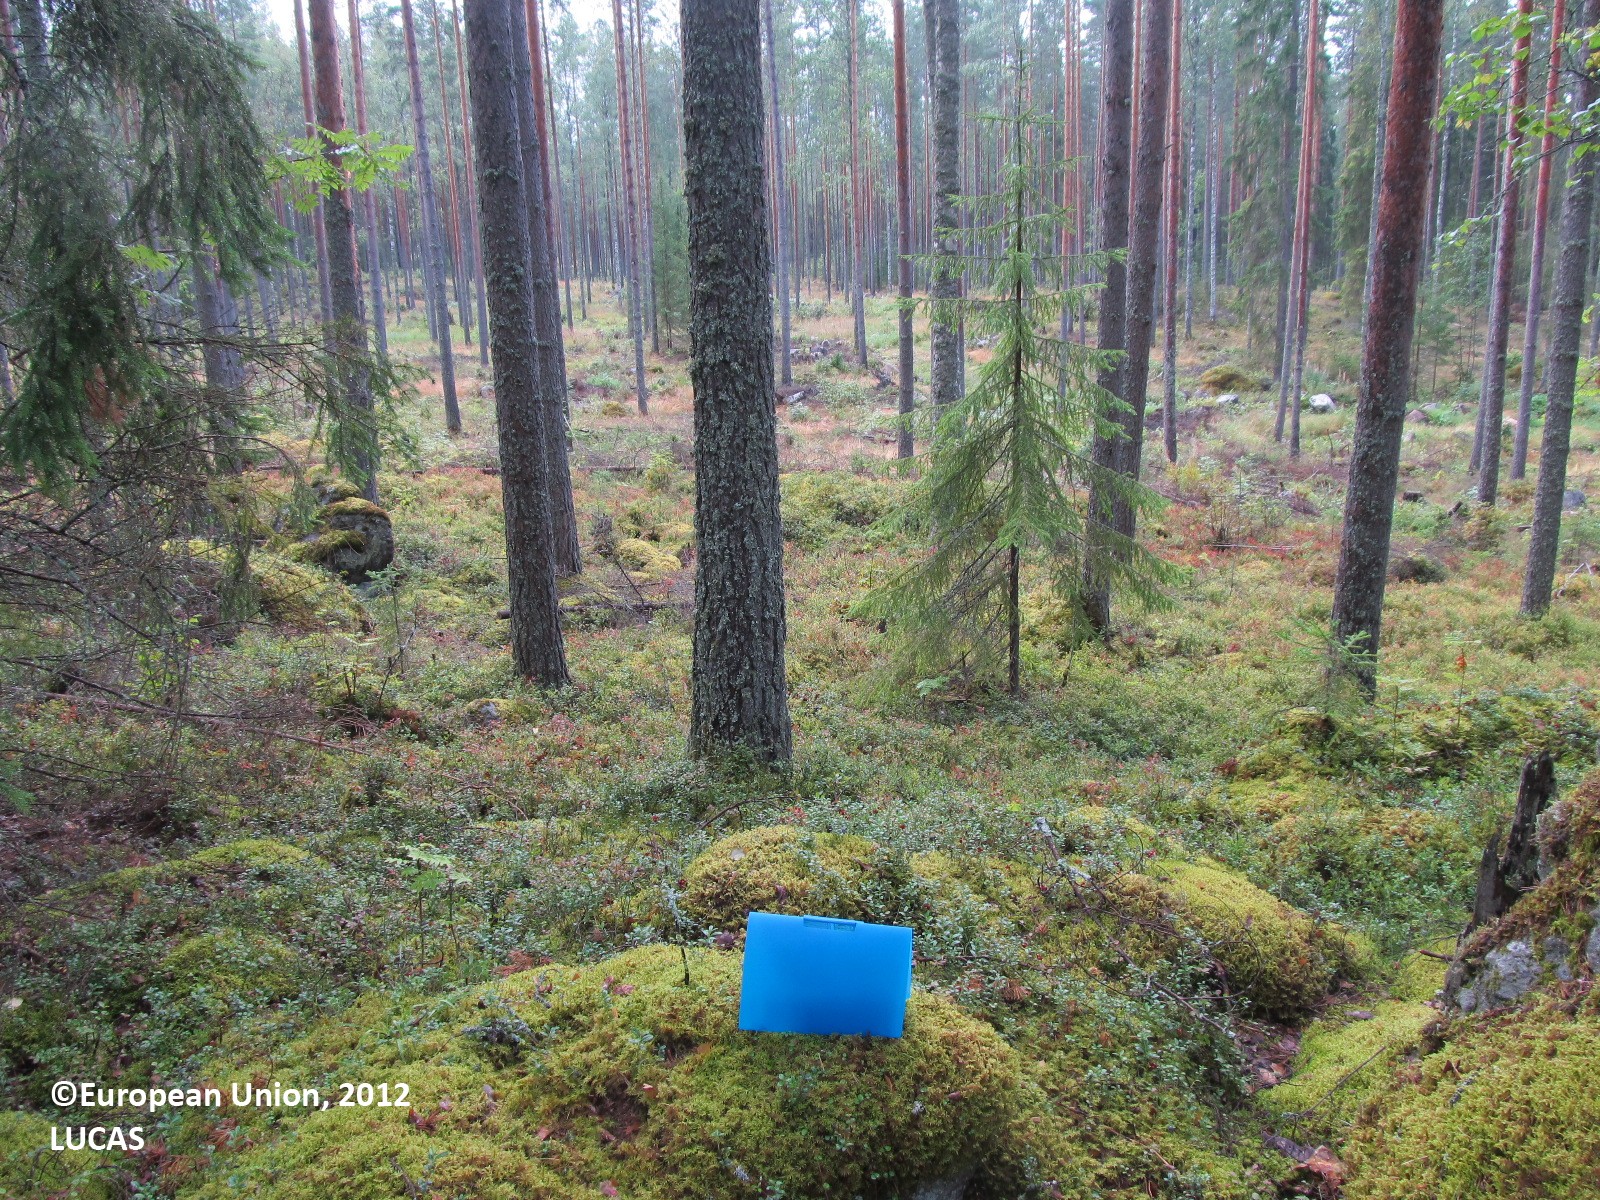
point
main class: Woodland
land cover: Pine dominated coniferous woodland
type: boreal forest
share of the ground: 25 - 50 %
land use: Forestry
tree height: > 5 m
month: August
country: FI
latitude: 62.9019
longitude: 27.5801
